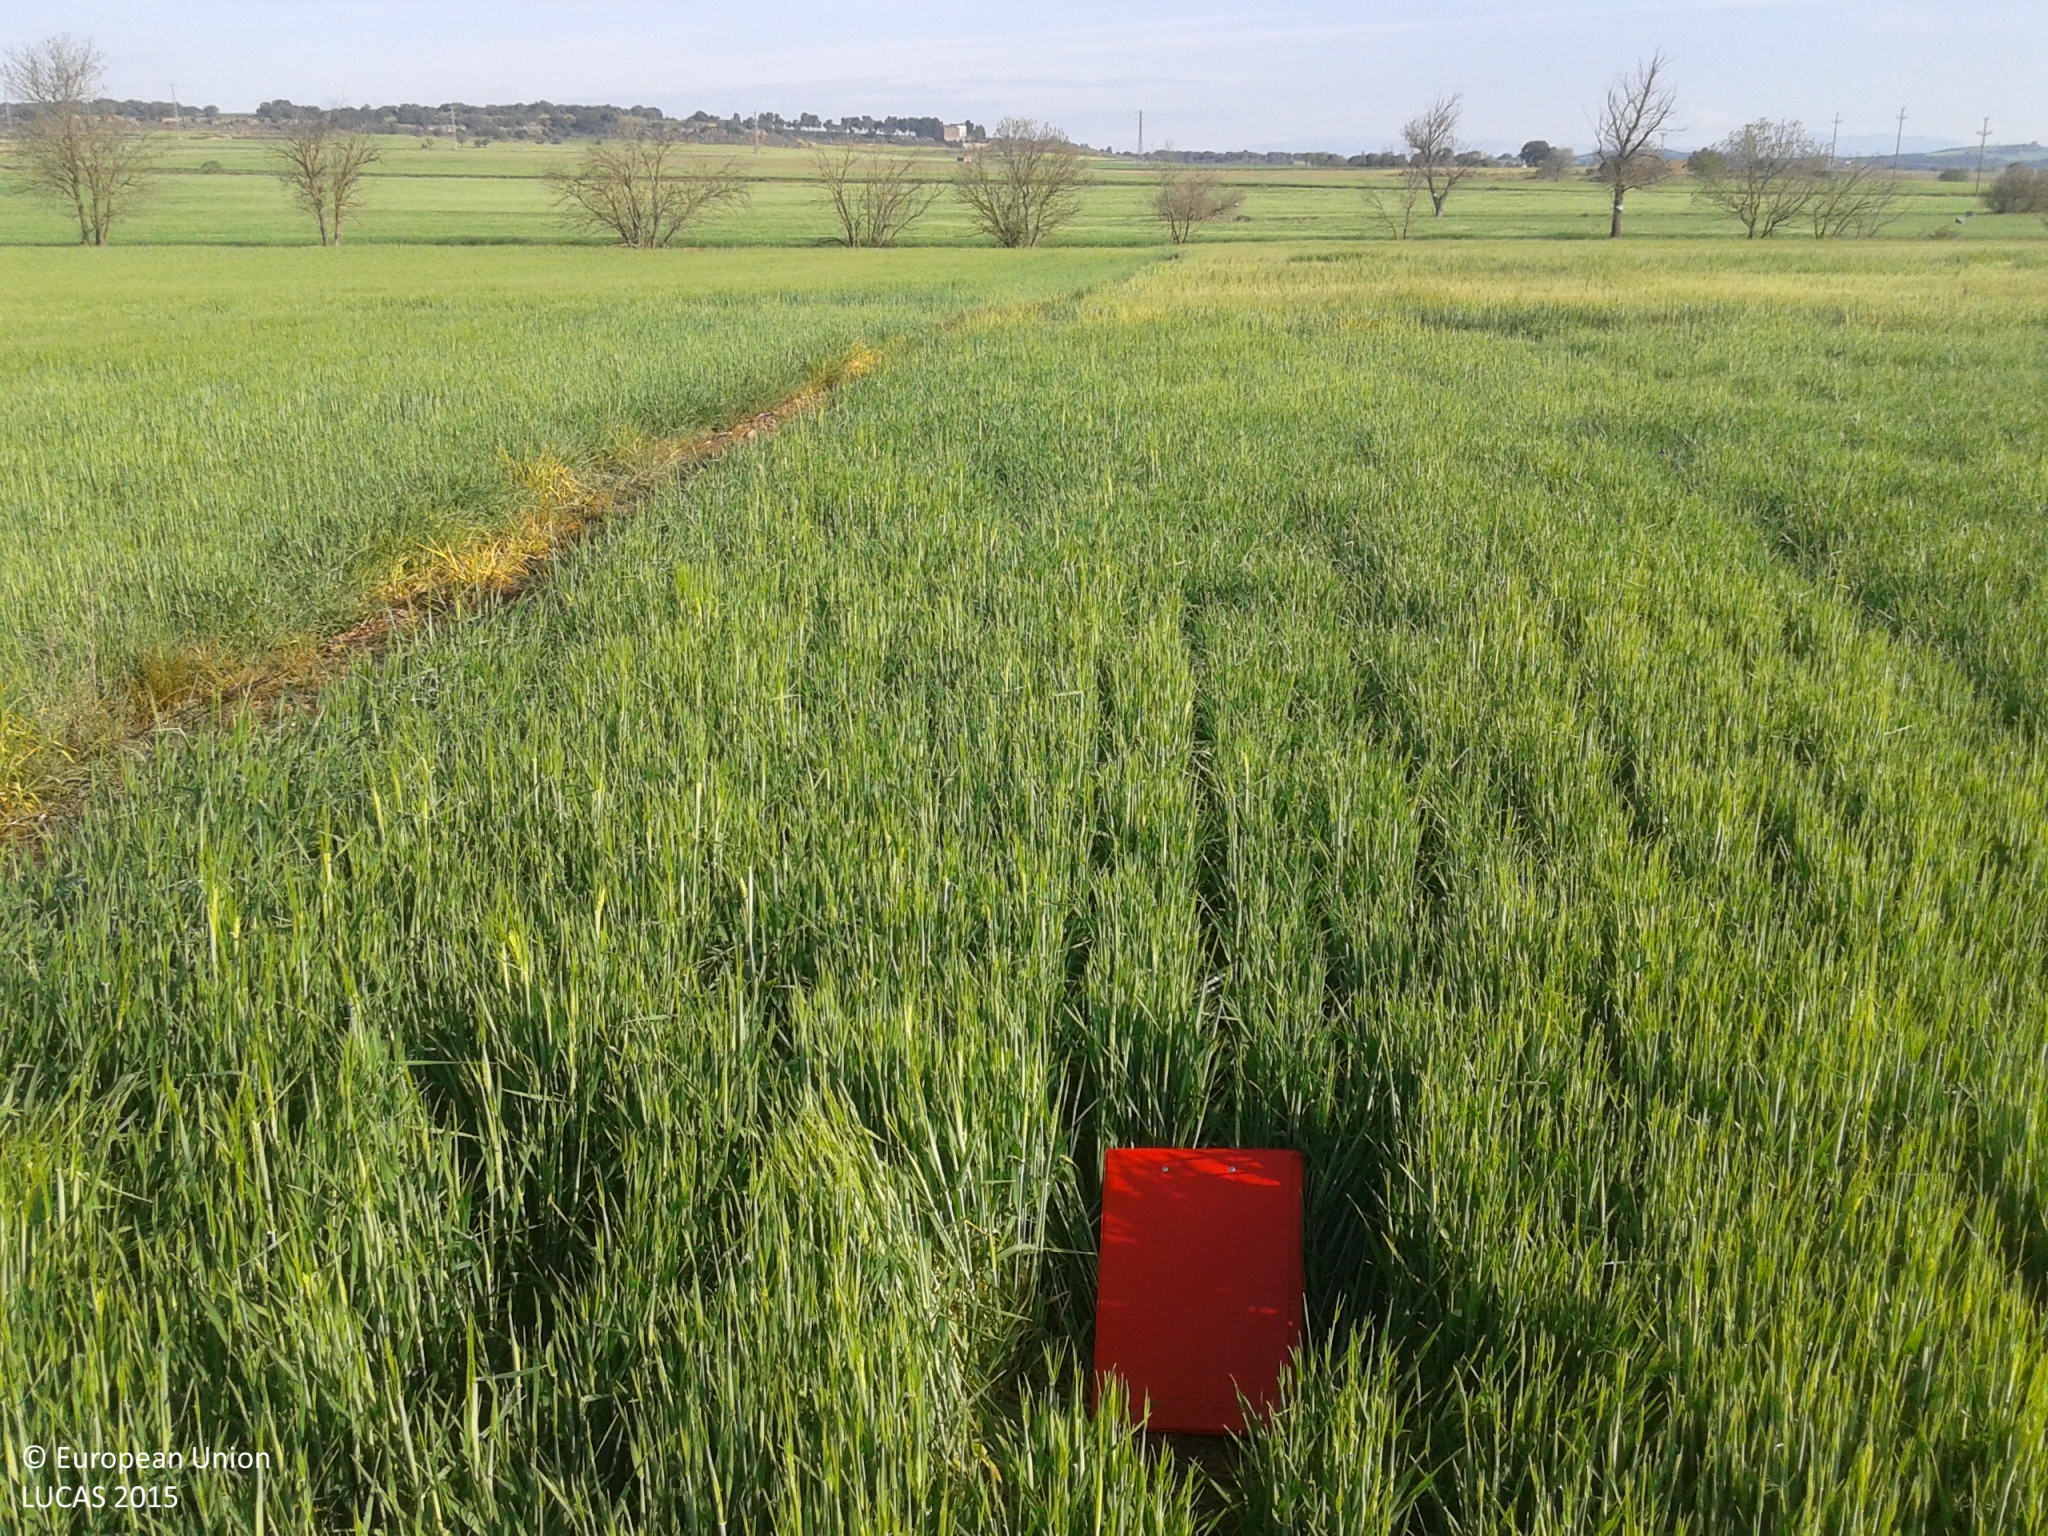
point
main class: Cropland
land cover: Barley
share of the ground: > 75 %
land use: Agriculture (excluding fallow land and kitchen gardens)
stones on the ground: 10 - 25 %
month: April
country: ES
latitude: 41.7595
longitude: 1.1726
